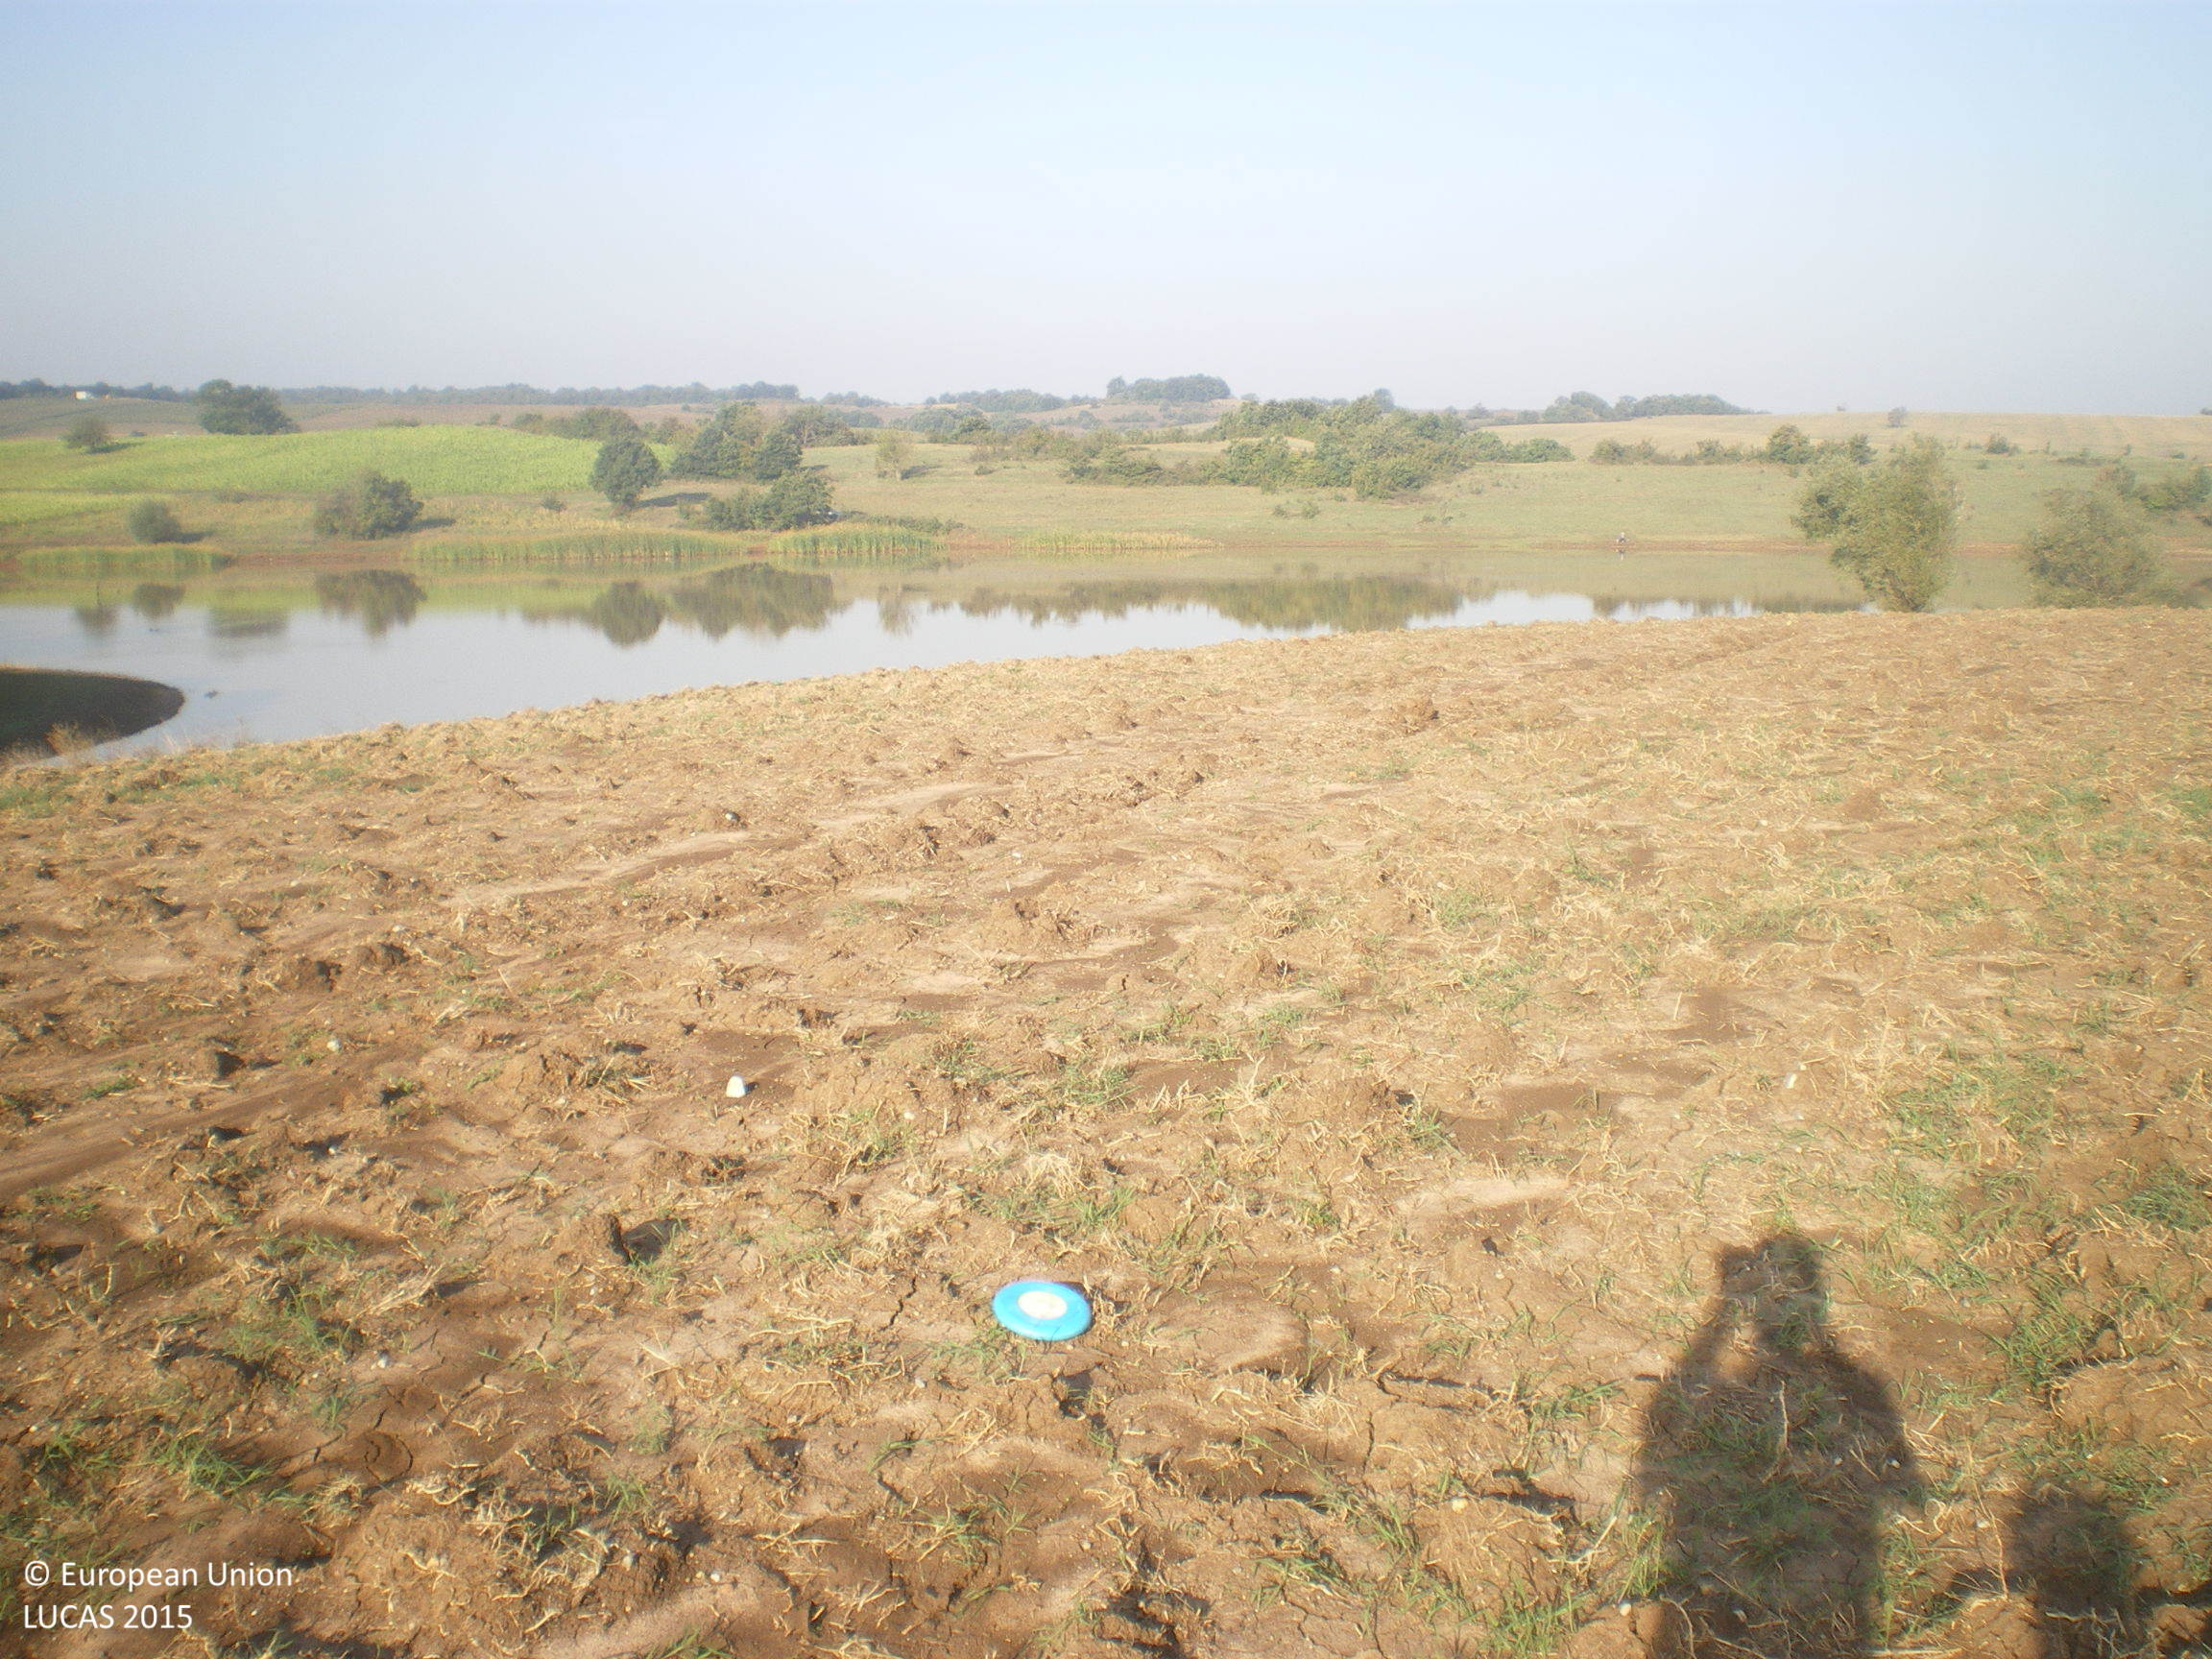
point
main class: Cropland
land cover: Common wheat
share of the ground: < 10 %
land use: Agriculture (excluding fallow land and kitchen gardens)
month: September
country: BG
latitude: 41.8152
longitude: 25.8753
